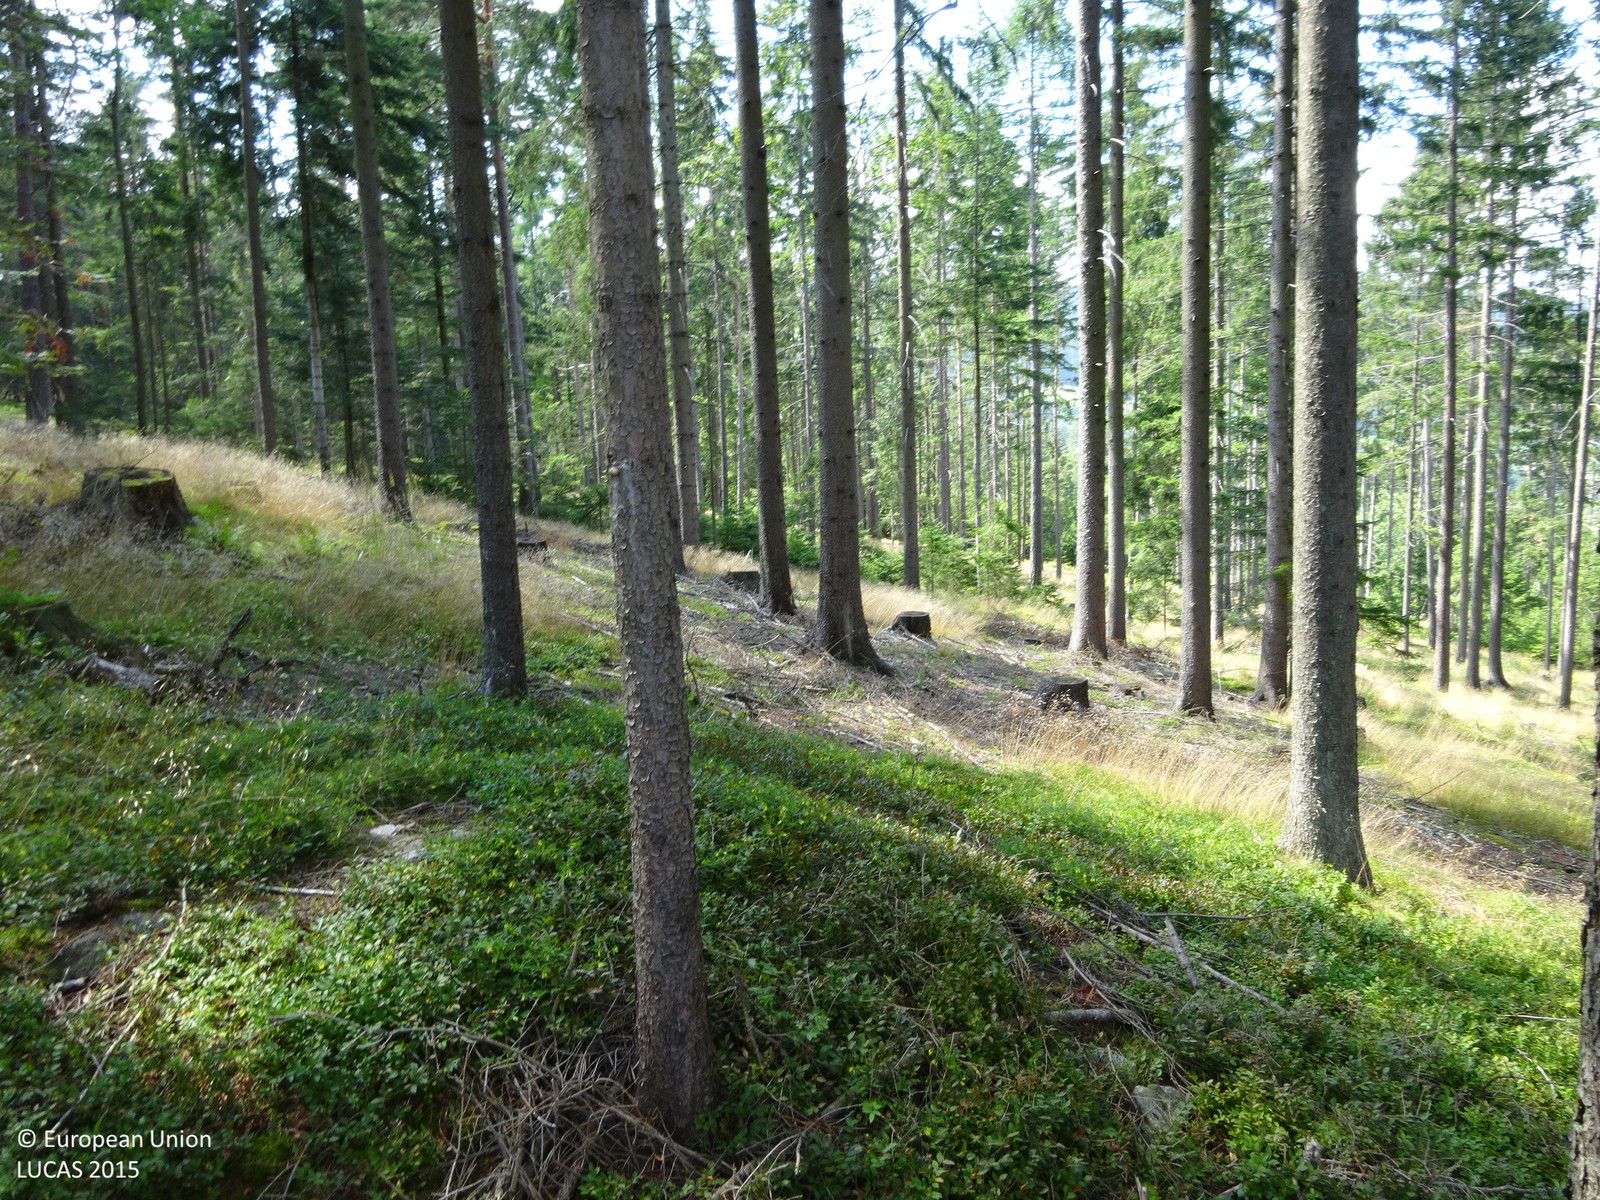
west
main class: Woodland
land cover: Spruce dominated coniferous woodland
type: alpine coniferous forest
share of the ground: > 75 %
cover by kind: coniferous forest trees 95 %, herbaceous plants 5 %
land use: Forestry
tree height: > 5 m
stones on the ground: < 10 %
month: August
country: AT
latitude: 47.3154
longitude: 15.7558
